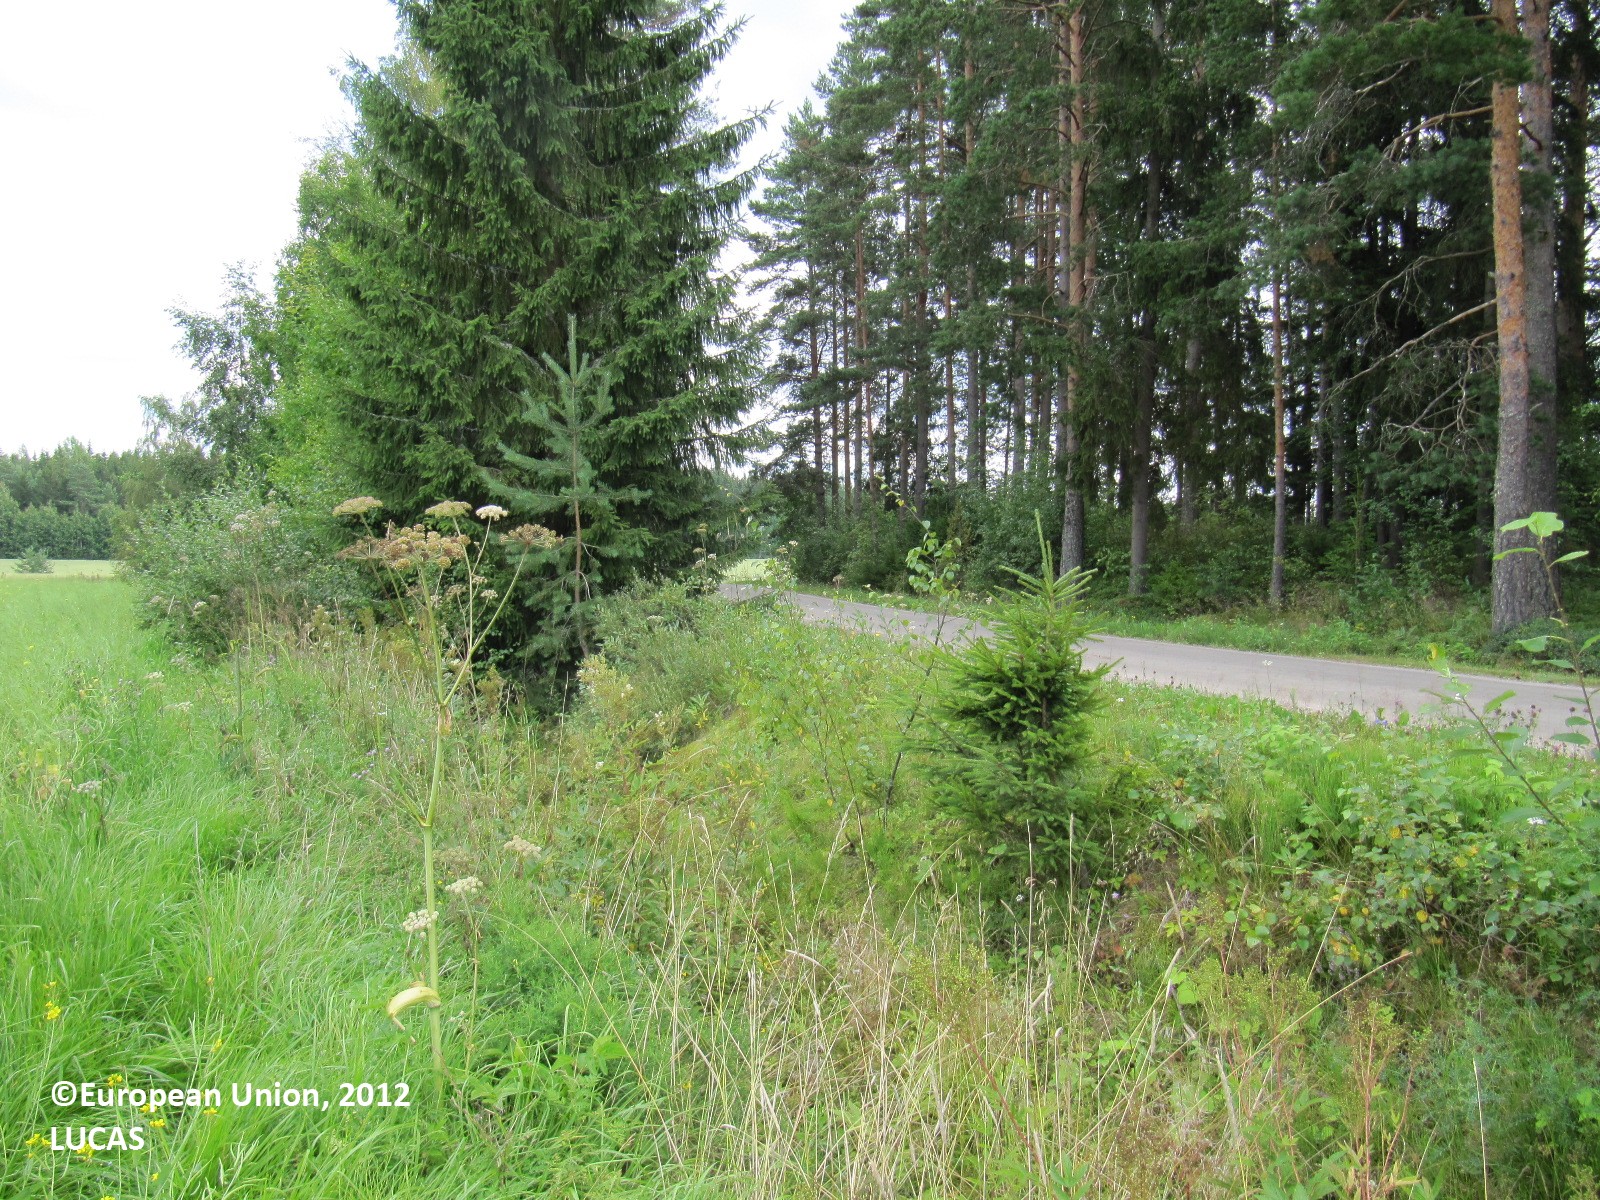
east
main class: Cropland
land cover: Rape and turnip rape
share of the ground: > 75 %
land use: Agriculture (excluding fallow land and kitchen gardens)
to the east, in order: Rape and turnip rape; Grass margins; Ditches and canals; Pine dominated mixed woodland; Ditches and canals; Common wheat; Spontaneously vegetated surfaces; Ditches and canals; Spontaneously vegetated surfaces; Common wheat
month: August
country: FI
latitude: 60.4155
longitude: 23.2106
